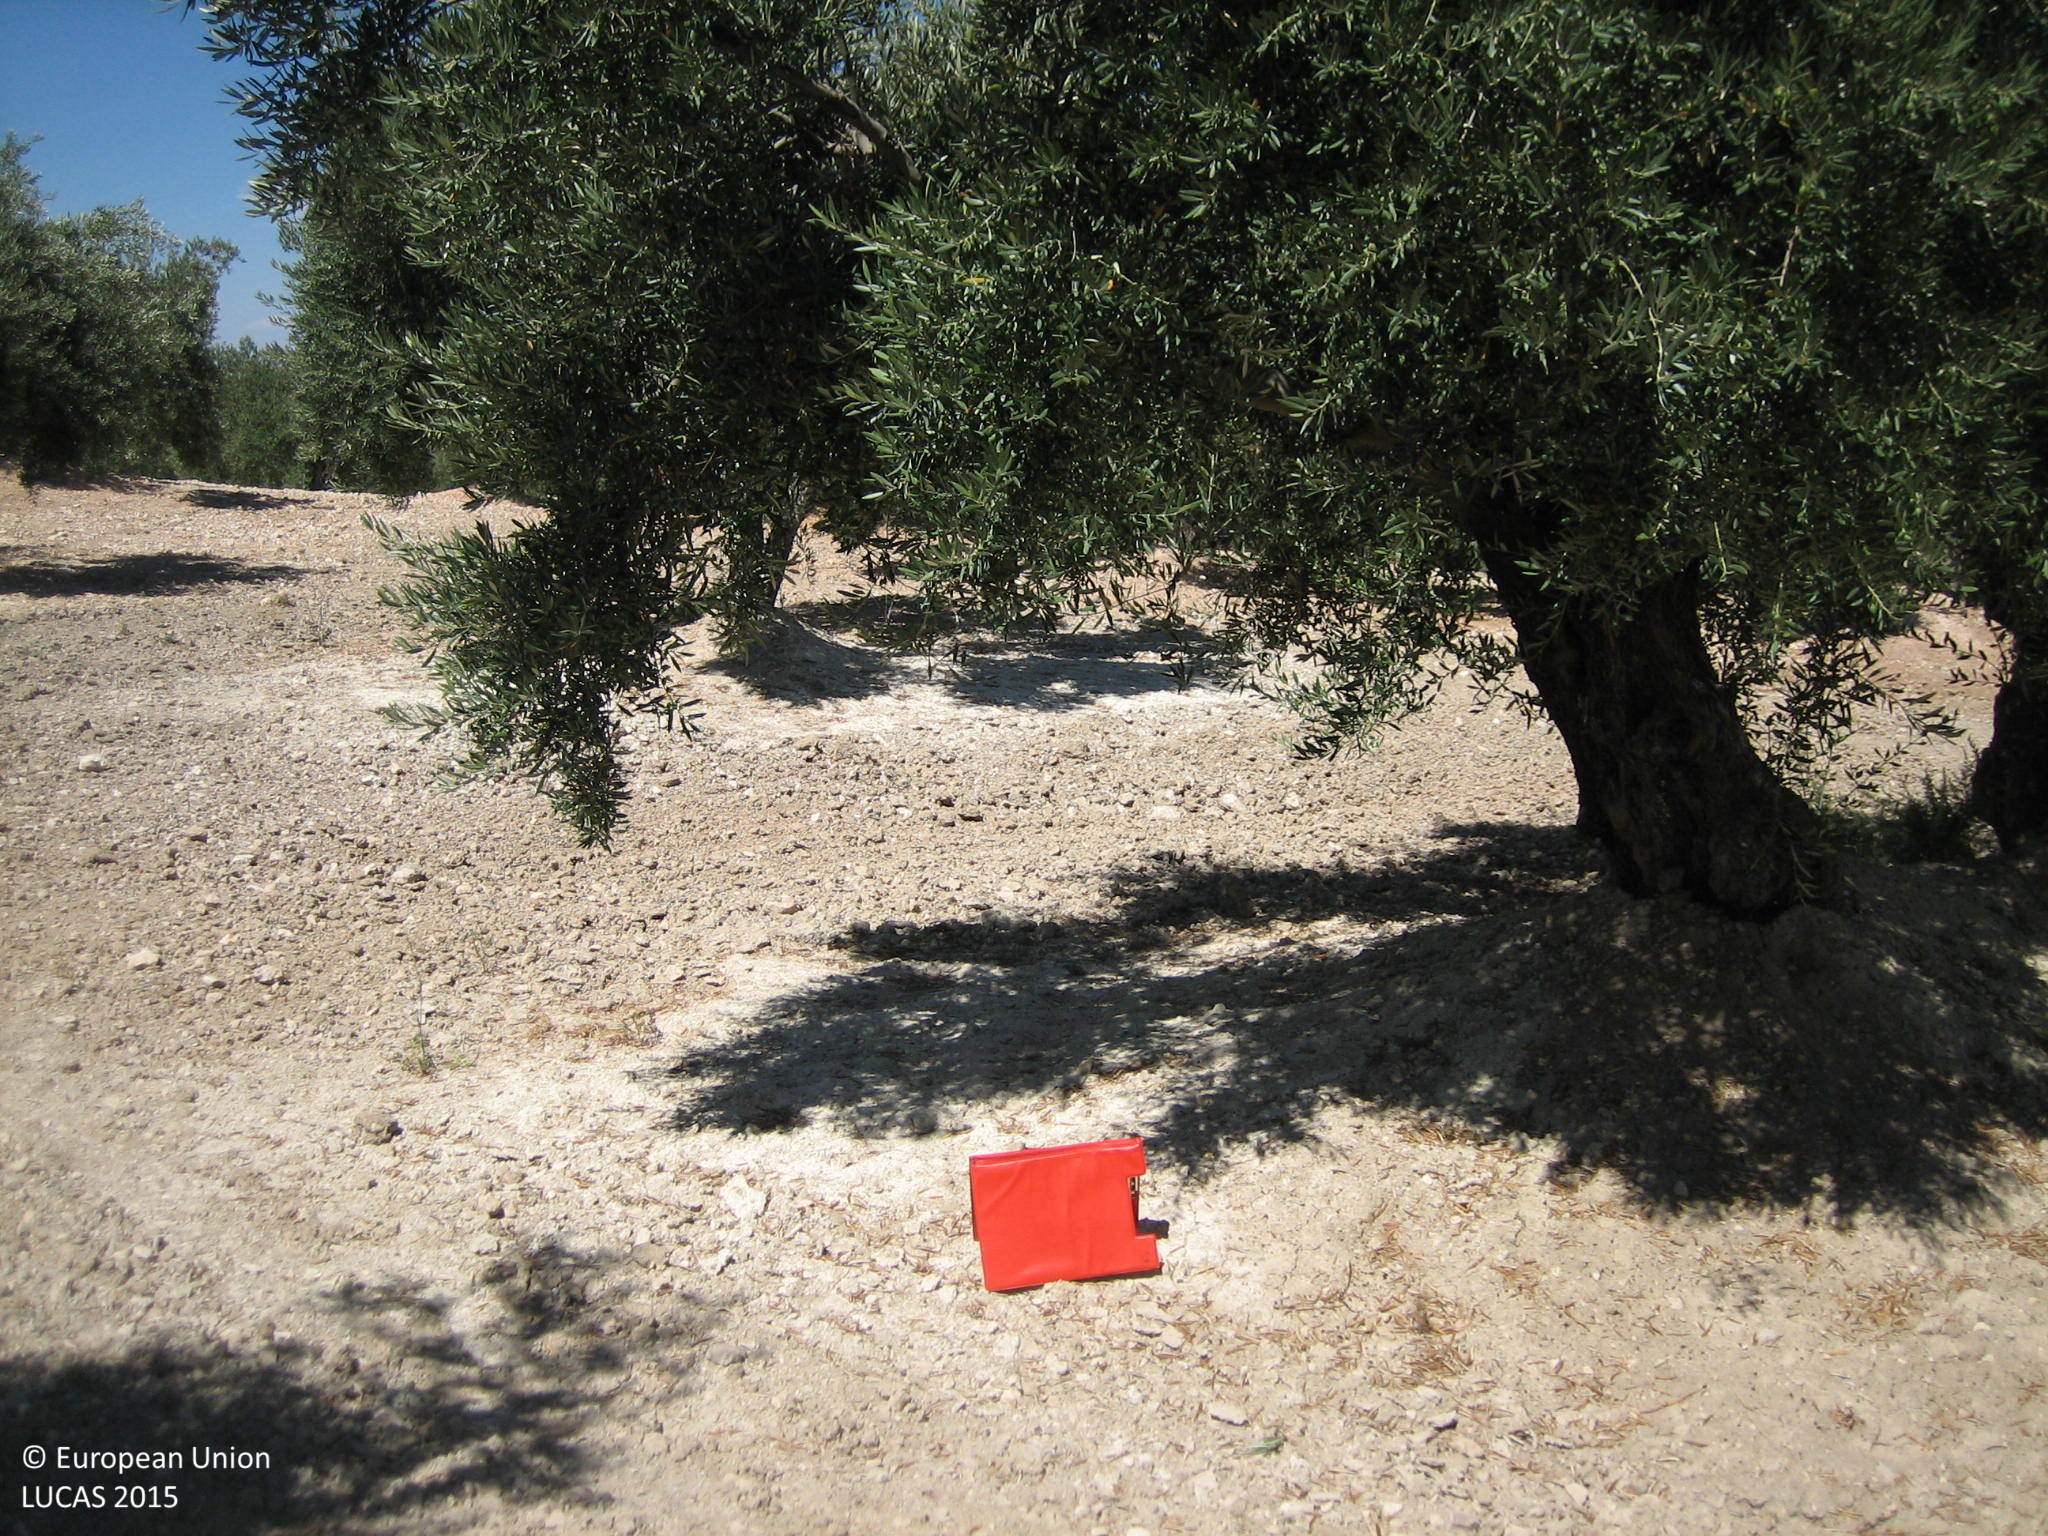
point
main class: Cropland
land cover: Olive groves
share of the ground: 25 - 50 %
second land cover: Other bare soil
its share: > 75 %
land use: Agriculture (excluding fallow land and kitchen gardens)
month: June
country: ES
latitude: 37.7299
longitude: -3.7858
